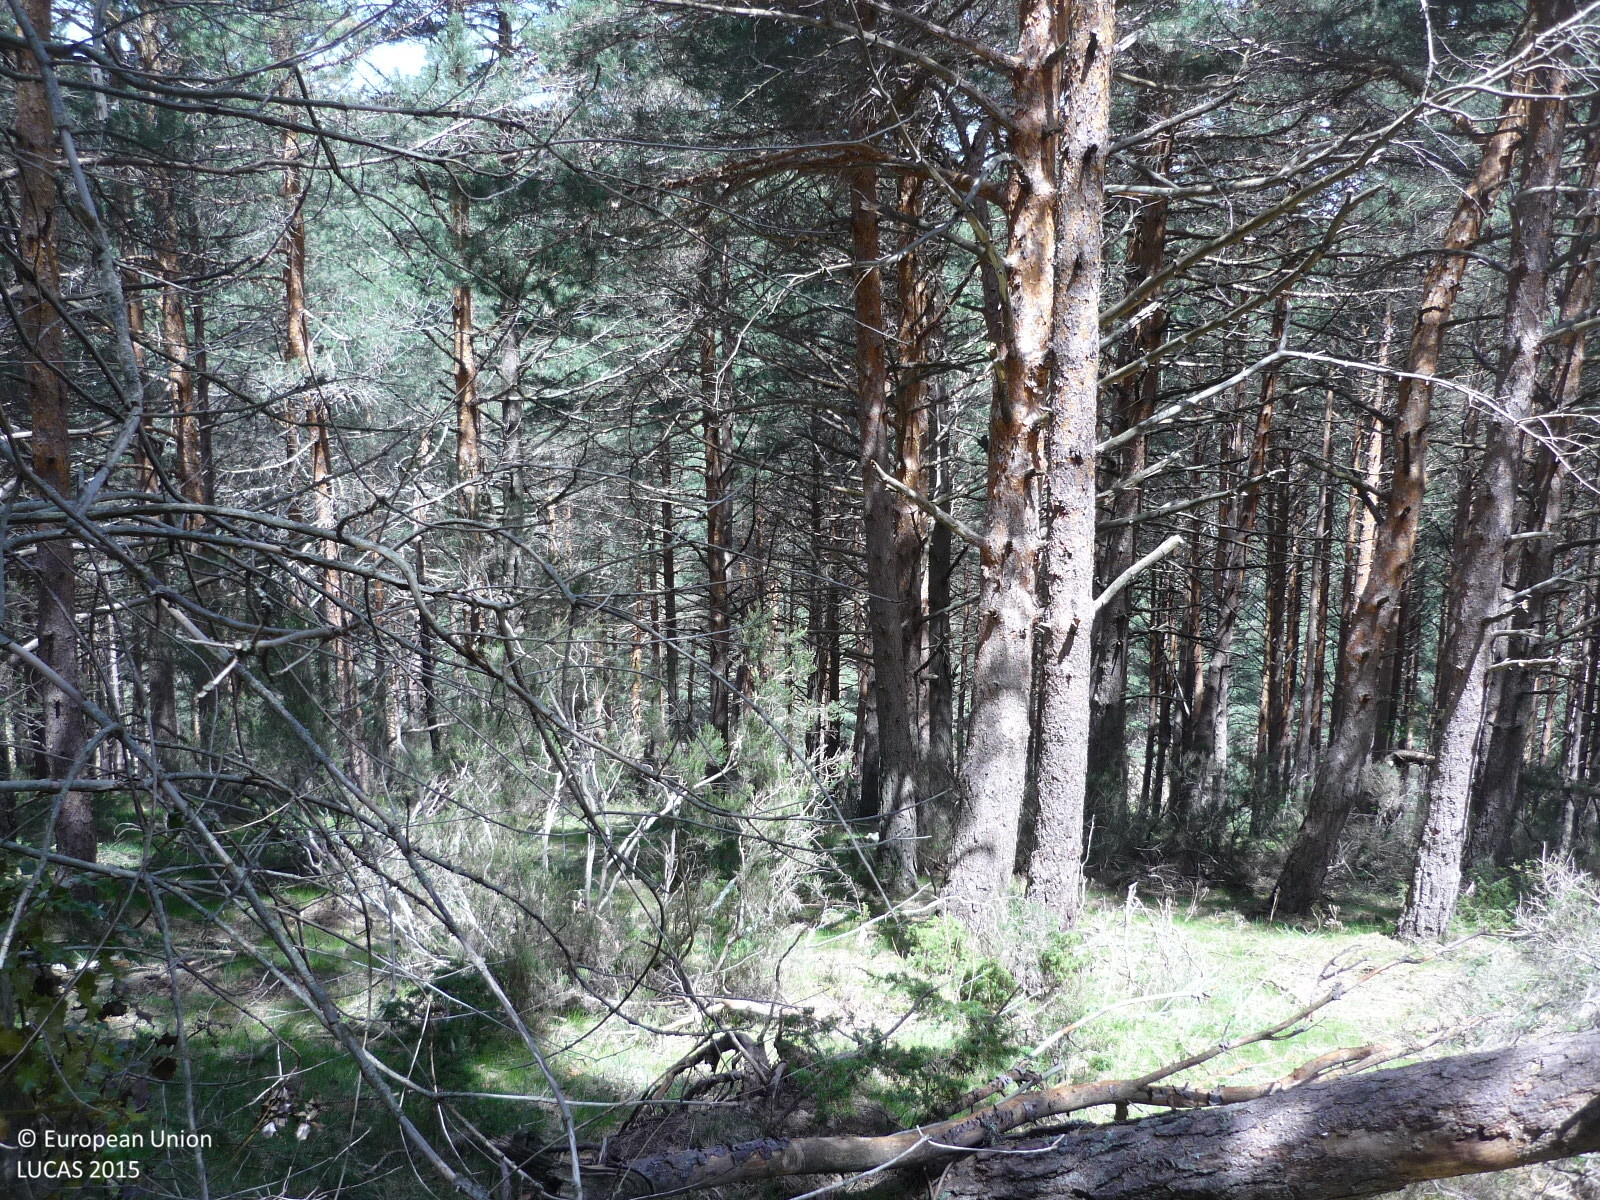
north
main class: Woodland
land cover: Pine dominated coniferous woodland
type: coniferous forest of the mediterranean region
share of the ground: > 75 %
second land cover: Grassland without tree/shrub cover
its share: > 75 %
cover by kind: coniferous forest trees 90 %, herbaceous plants 10 %
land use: Forestry
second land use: Agriculture (excluding fallow land and kitchen gardens)
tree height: > 5 m
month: April
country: ES
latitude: 41.1265
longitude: -3.6122
